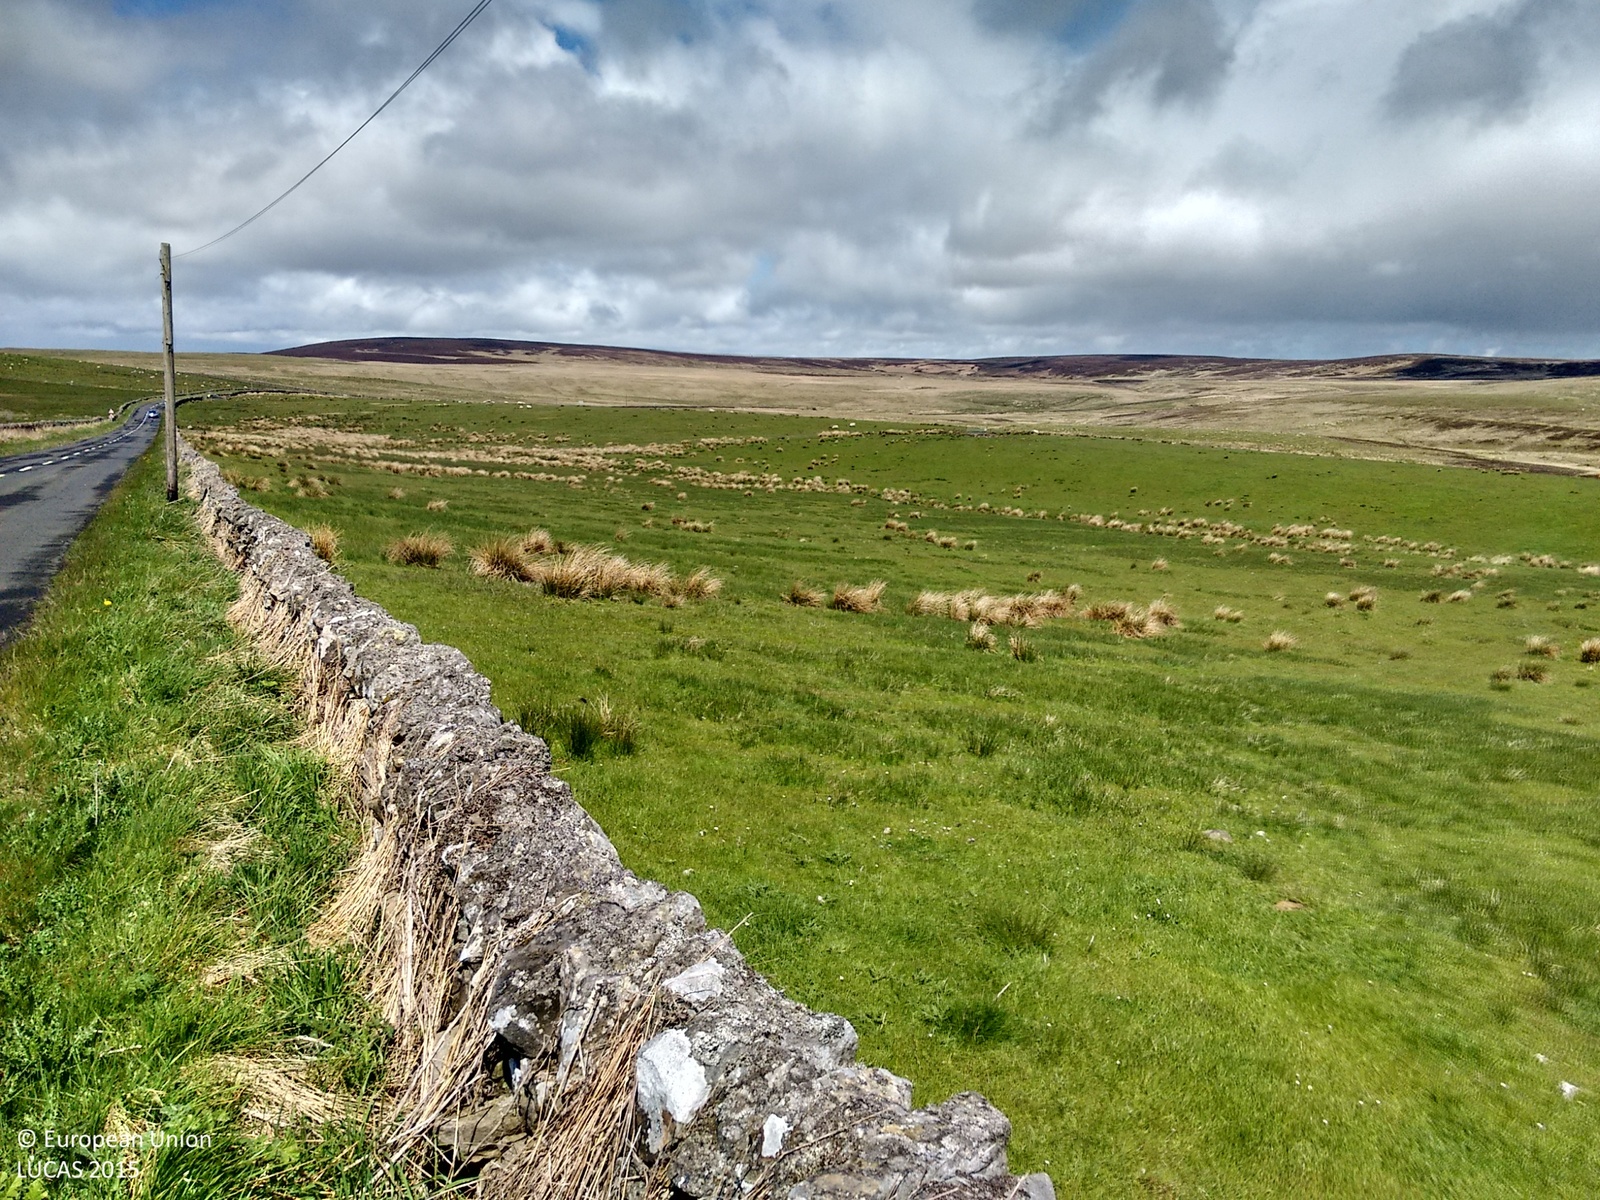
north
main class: Grassland
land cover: Grassland without tree/shrub cover
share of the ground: > 75 %
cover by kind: herbaceous plants 100 %
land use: Agriculture (excluding fallow land and kitchen gardens)
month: May
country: GB
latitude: 55.1785
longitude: -2.2592
